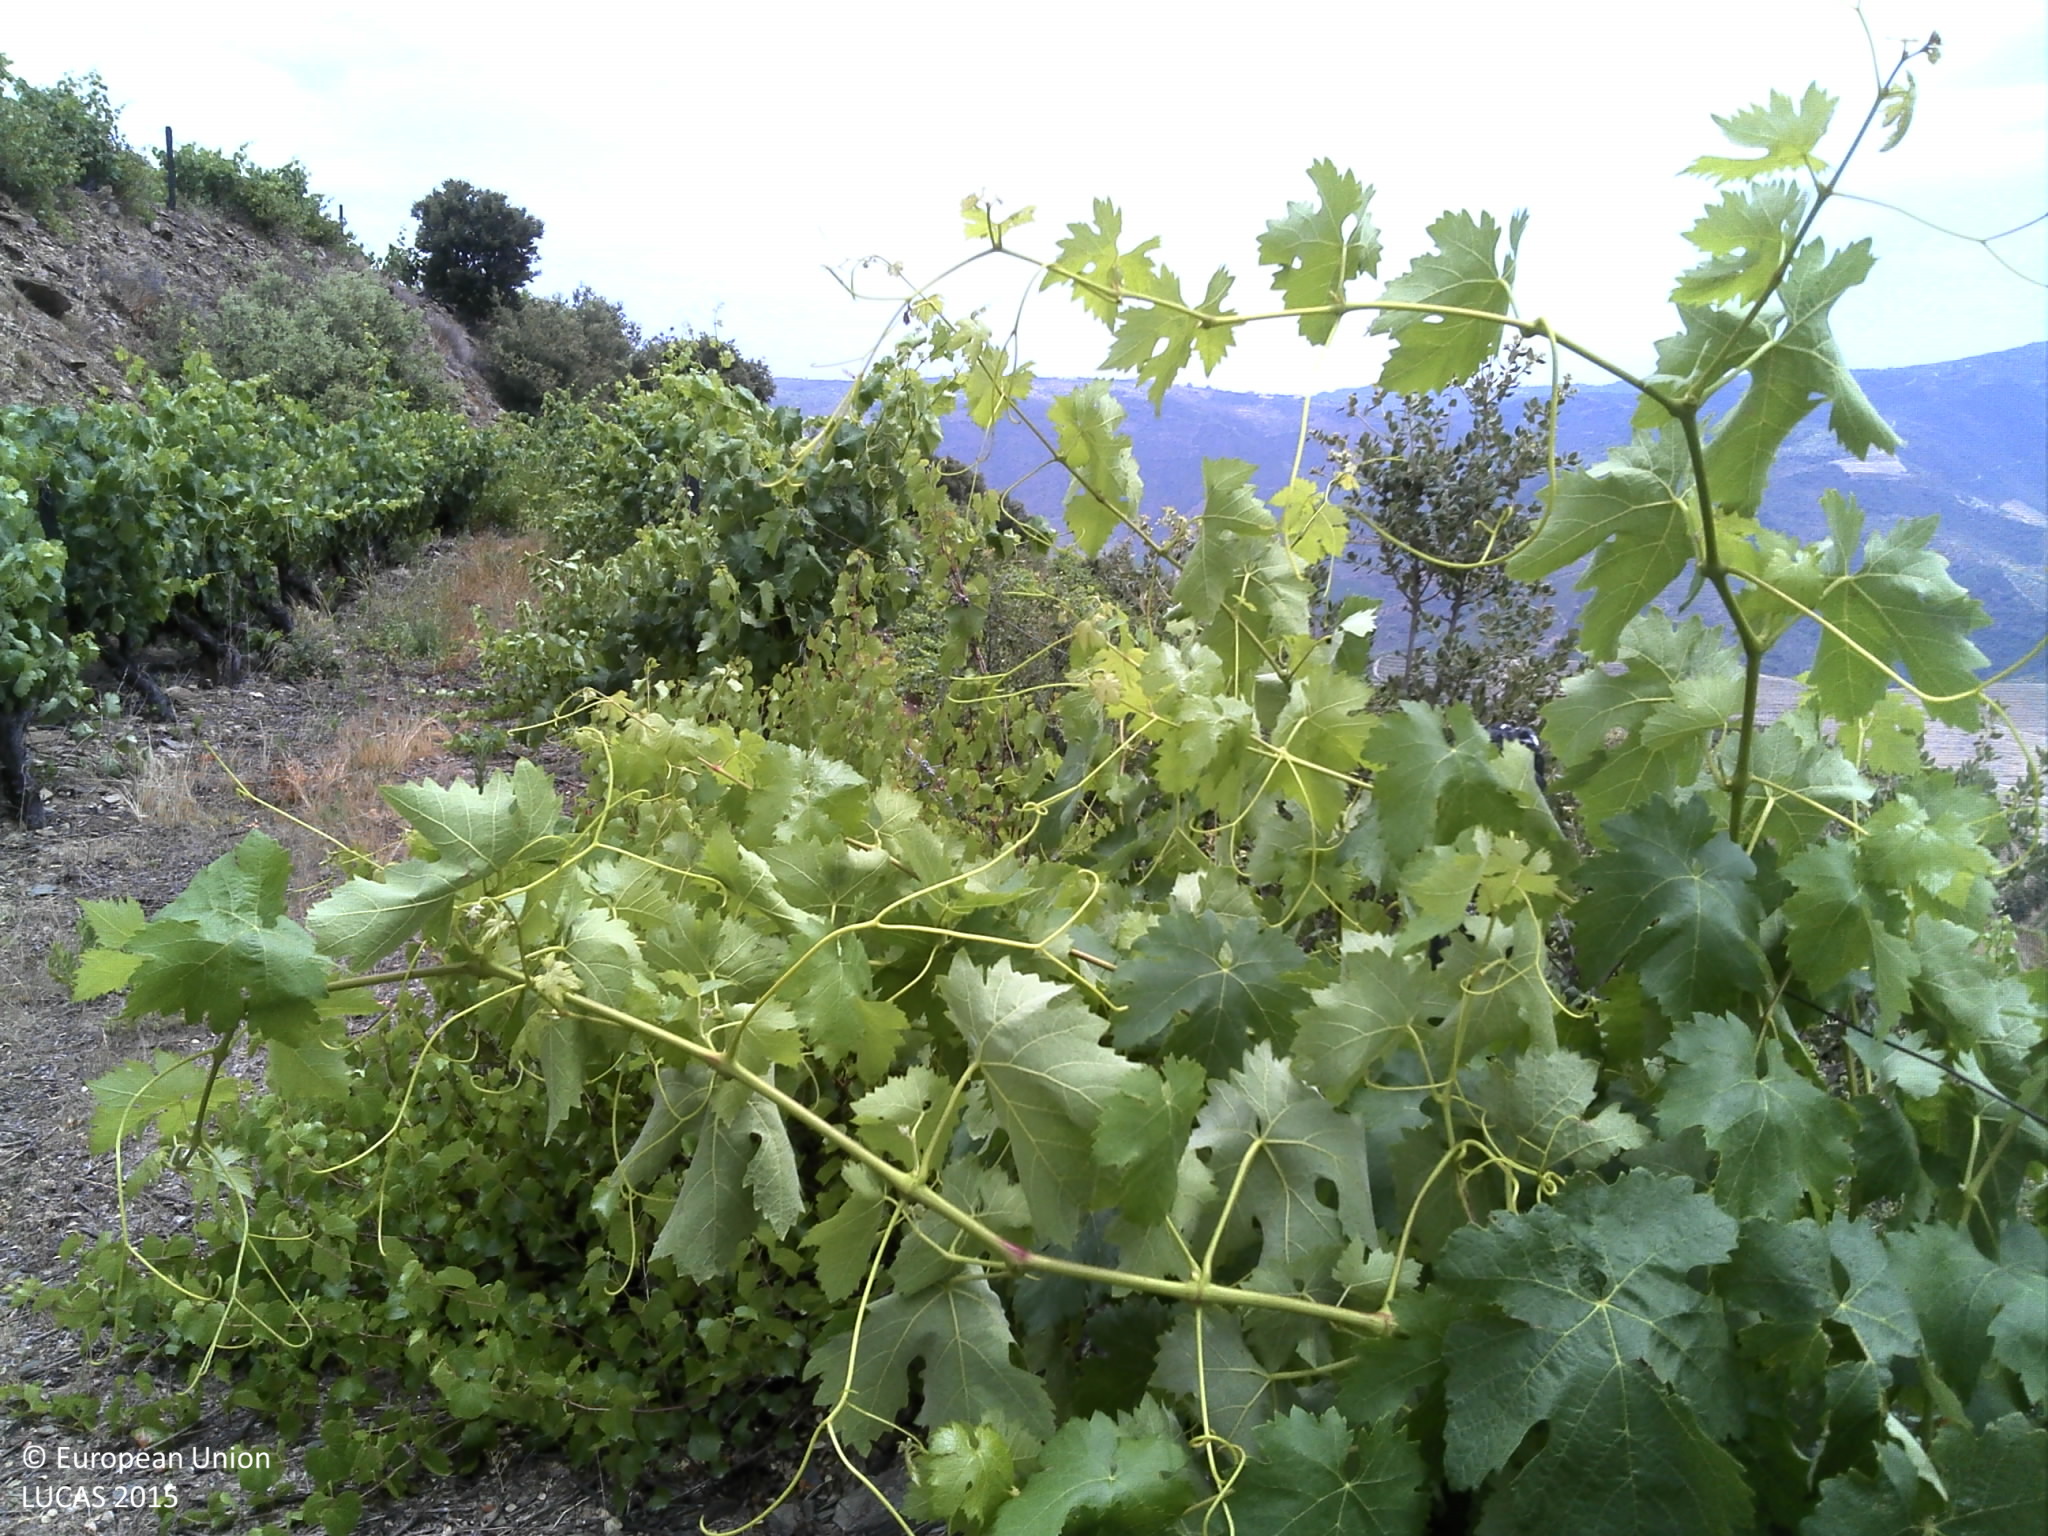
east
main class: Cropland
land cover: Vineyards
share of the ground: < 10 %
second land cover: Spontaneously vegetated surfaces
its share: 25 - 50 %
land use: Agriculture (excluding fallow land and kitchen gardens)
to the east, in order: Vineyards; Spontaneously vegetated surfaces; Tracks; Grass margins; Tracks; Vineyards
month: June
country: PT
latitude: 41.1201
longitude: -7.3758
